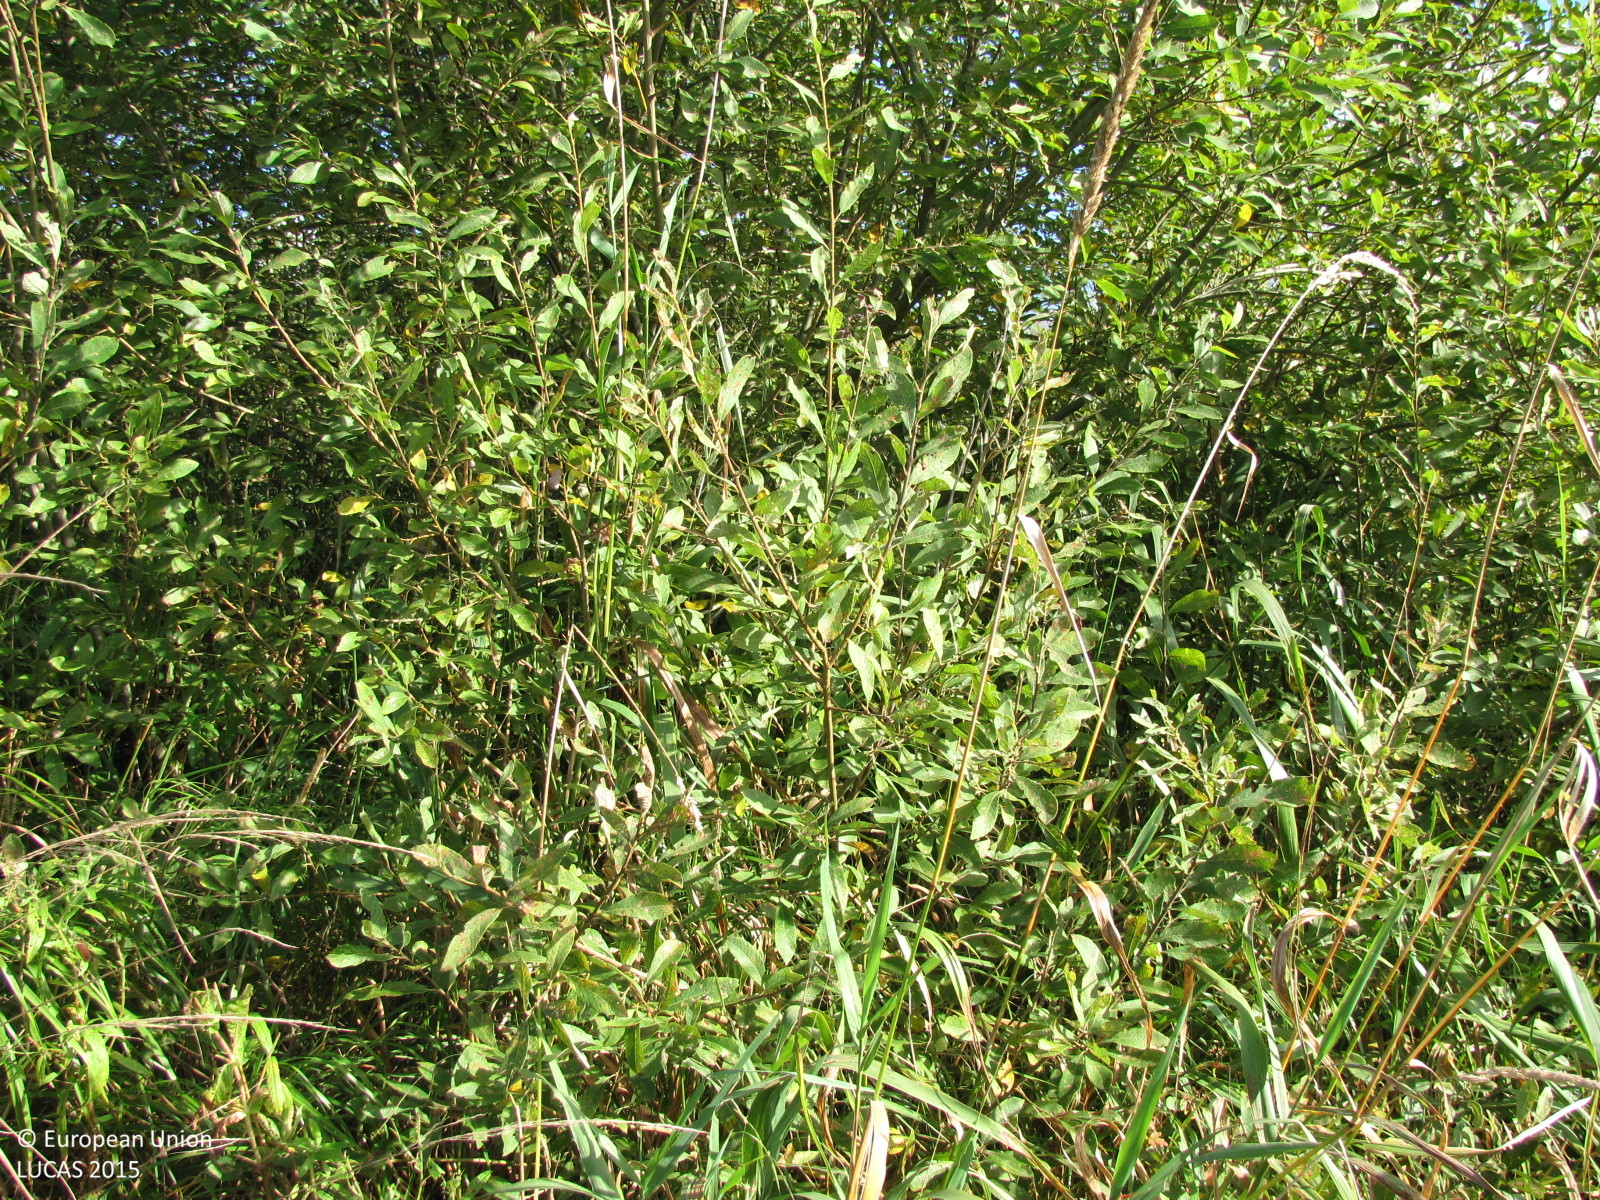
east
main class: Grassland
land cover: Grassland without tree/shrub cover
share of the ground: > 75 %
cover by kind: herbaceous plants 100 %
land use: Agriculture (excluding fallow land and kitchen gardens)
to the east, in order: Ditches and canals; Abandoned hedges; Grassland without tree/shrub cover; Broadleaved woodland; Paved roads, cycling and walking lanes; Grassland with sparse tree/shrub cover; Spruce dominated mixed woodland; Shrubland with sparse tree cover; Broadleaved woodland; Ditches and canals; Broadleaved woodland
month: September
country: LV
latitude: 56.8541
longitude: 25.1806
